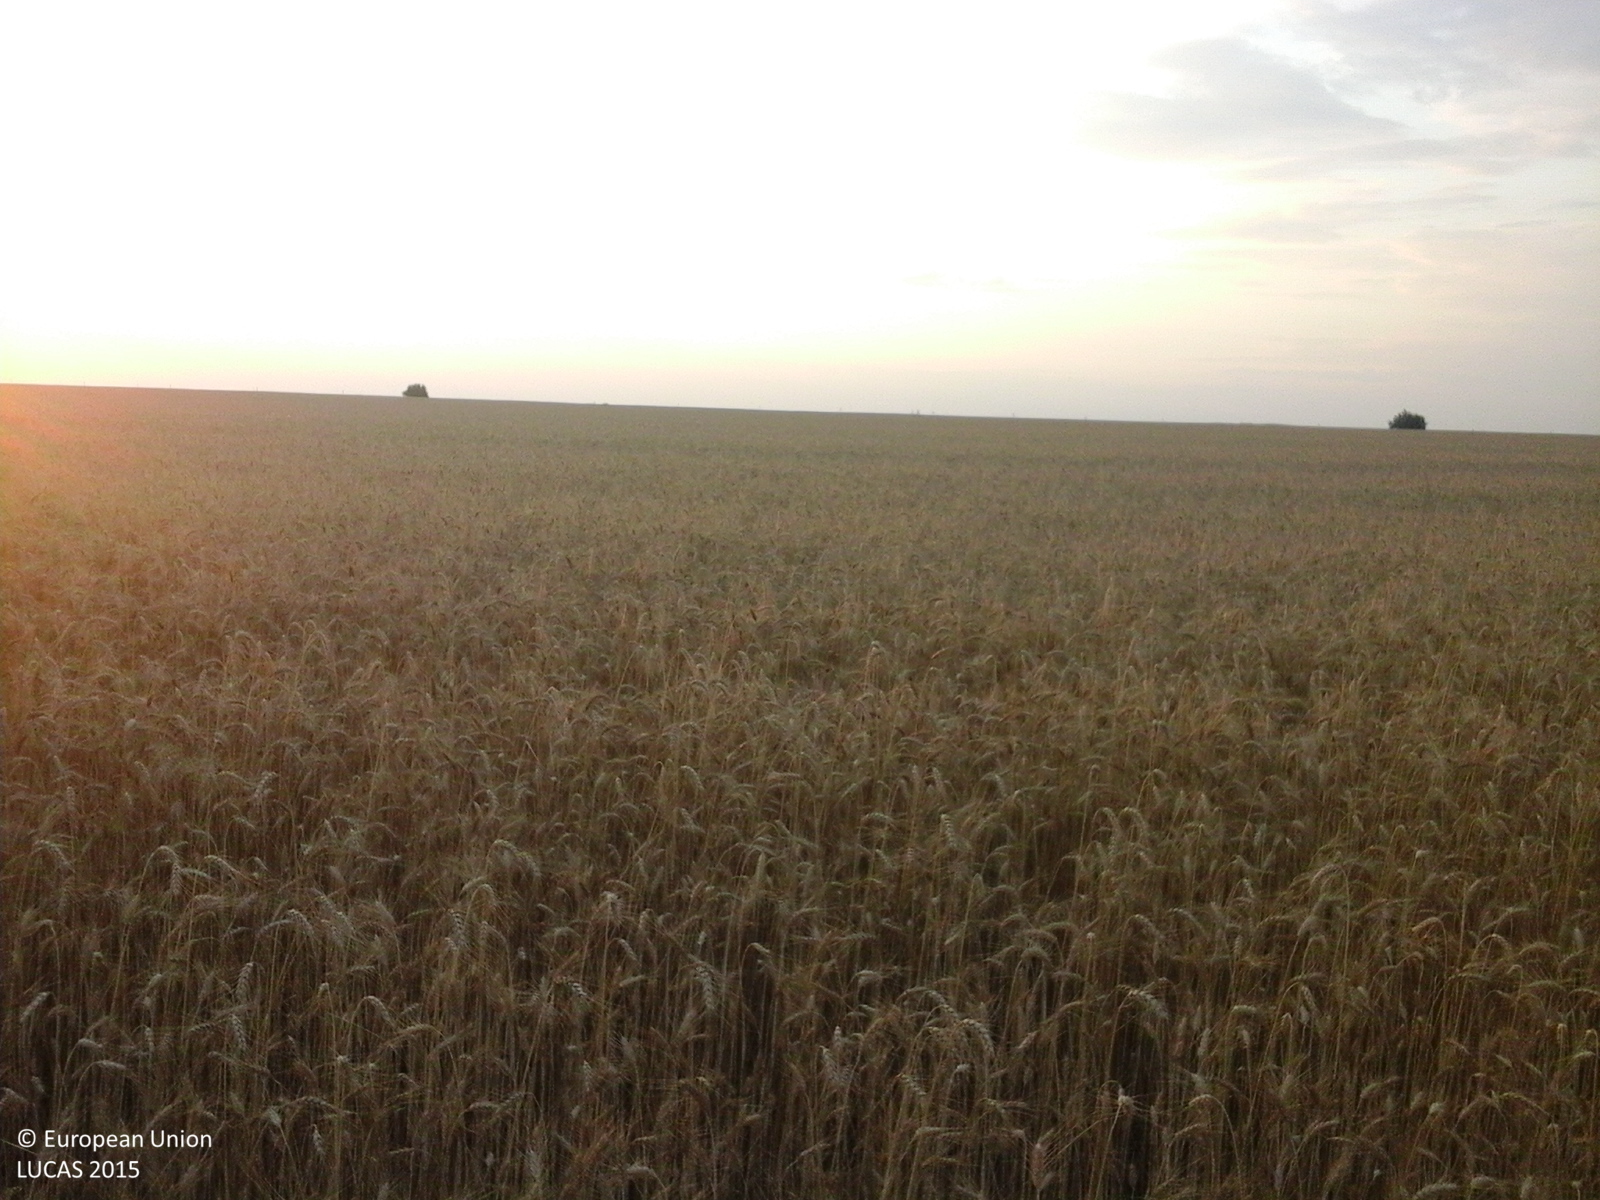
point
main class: Cropland
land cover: Common wheat
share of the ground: > 75 %
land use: Agriculture (excluding fallow land and kitchen gardens)
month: July
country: RO
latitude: 44.0069
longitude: 25.9493
